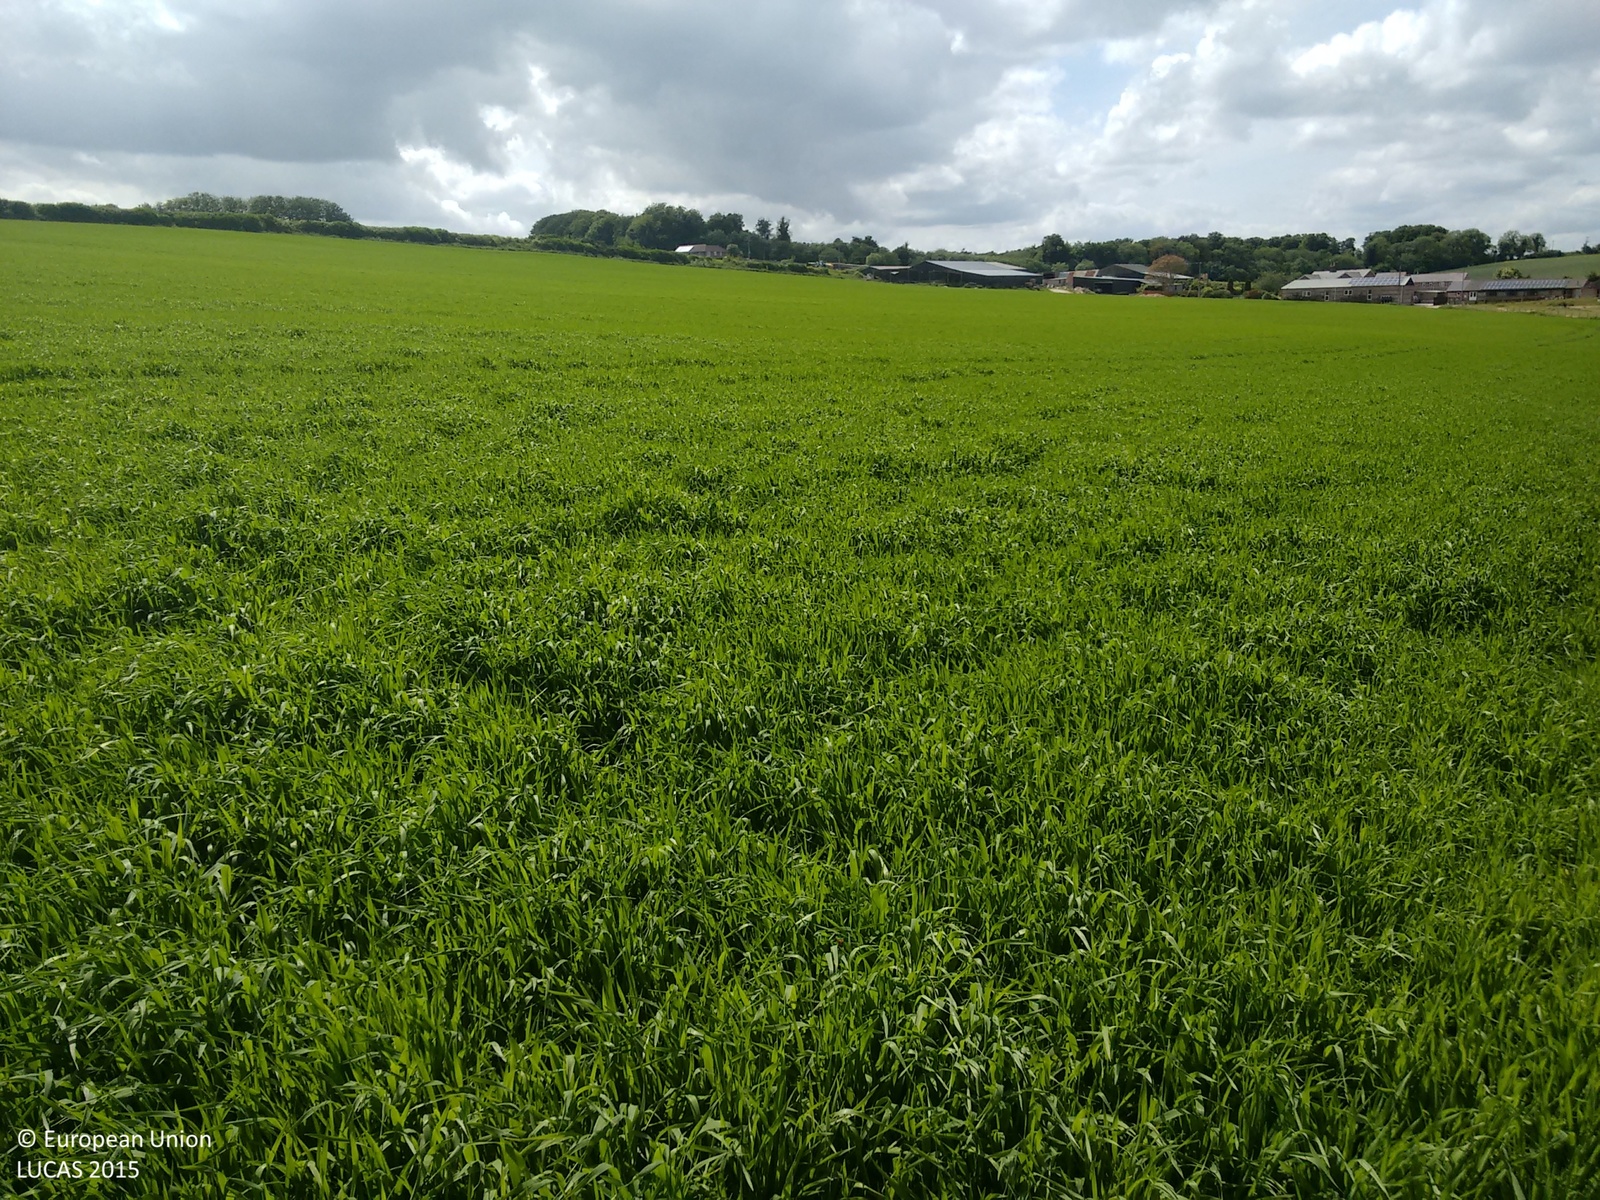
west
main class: Cropland
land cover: Barley
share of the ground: > 75 %
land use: Agriculture (excluding fallow land and kitchen gardens)
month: May
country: GB
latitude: 50.8209
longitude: -2.1692
